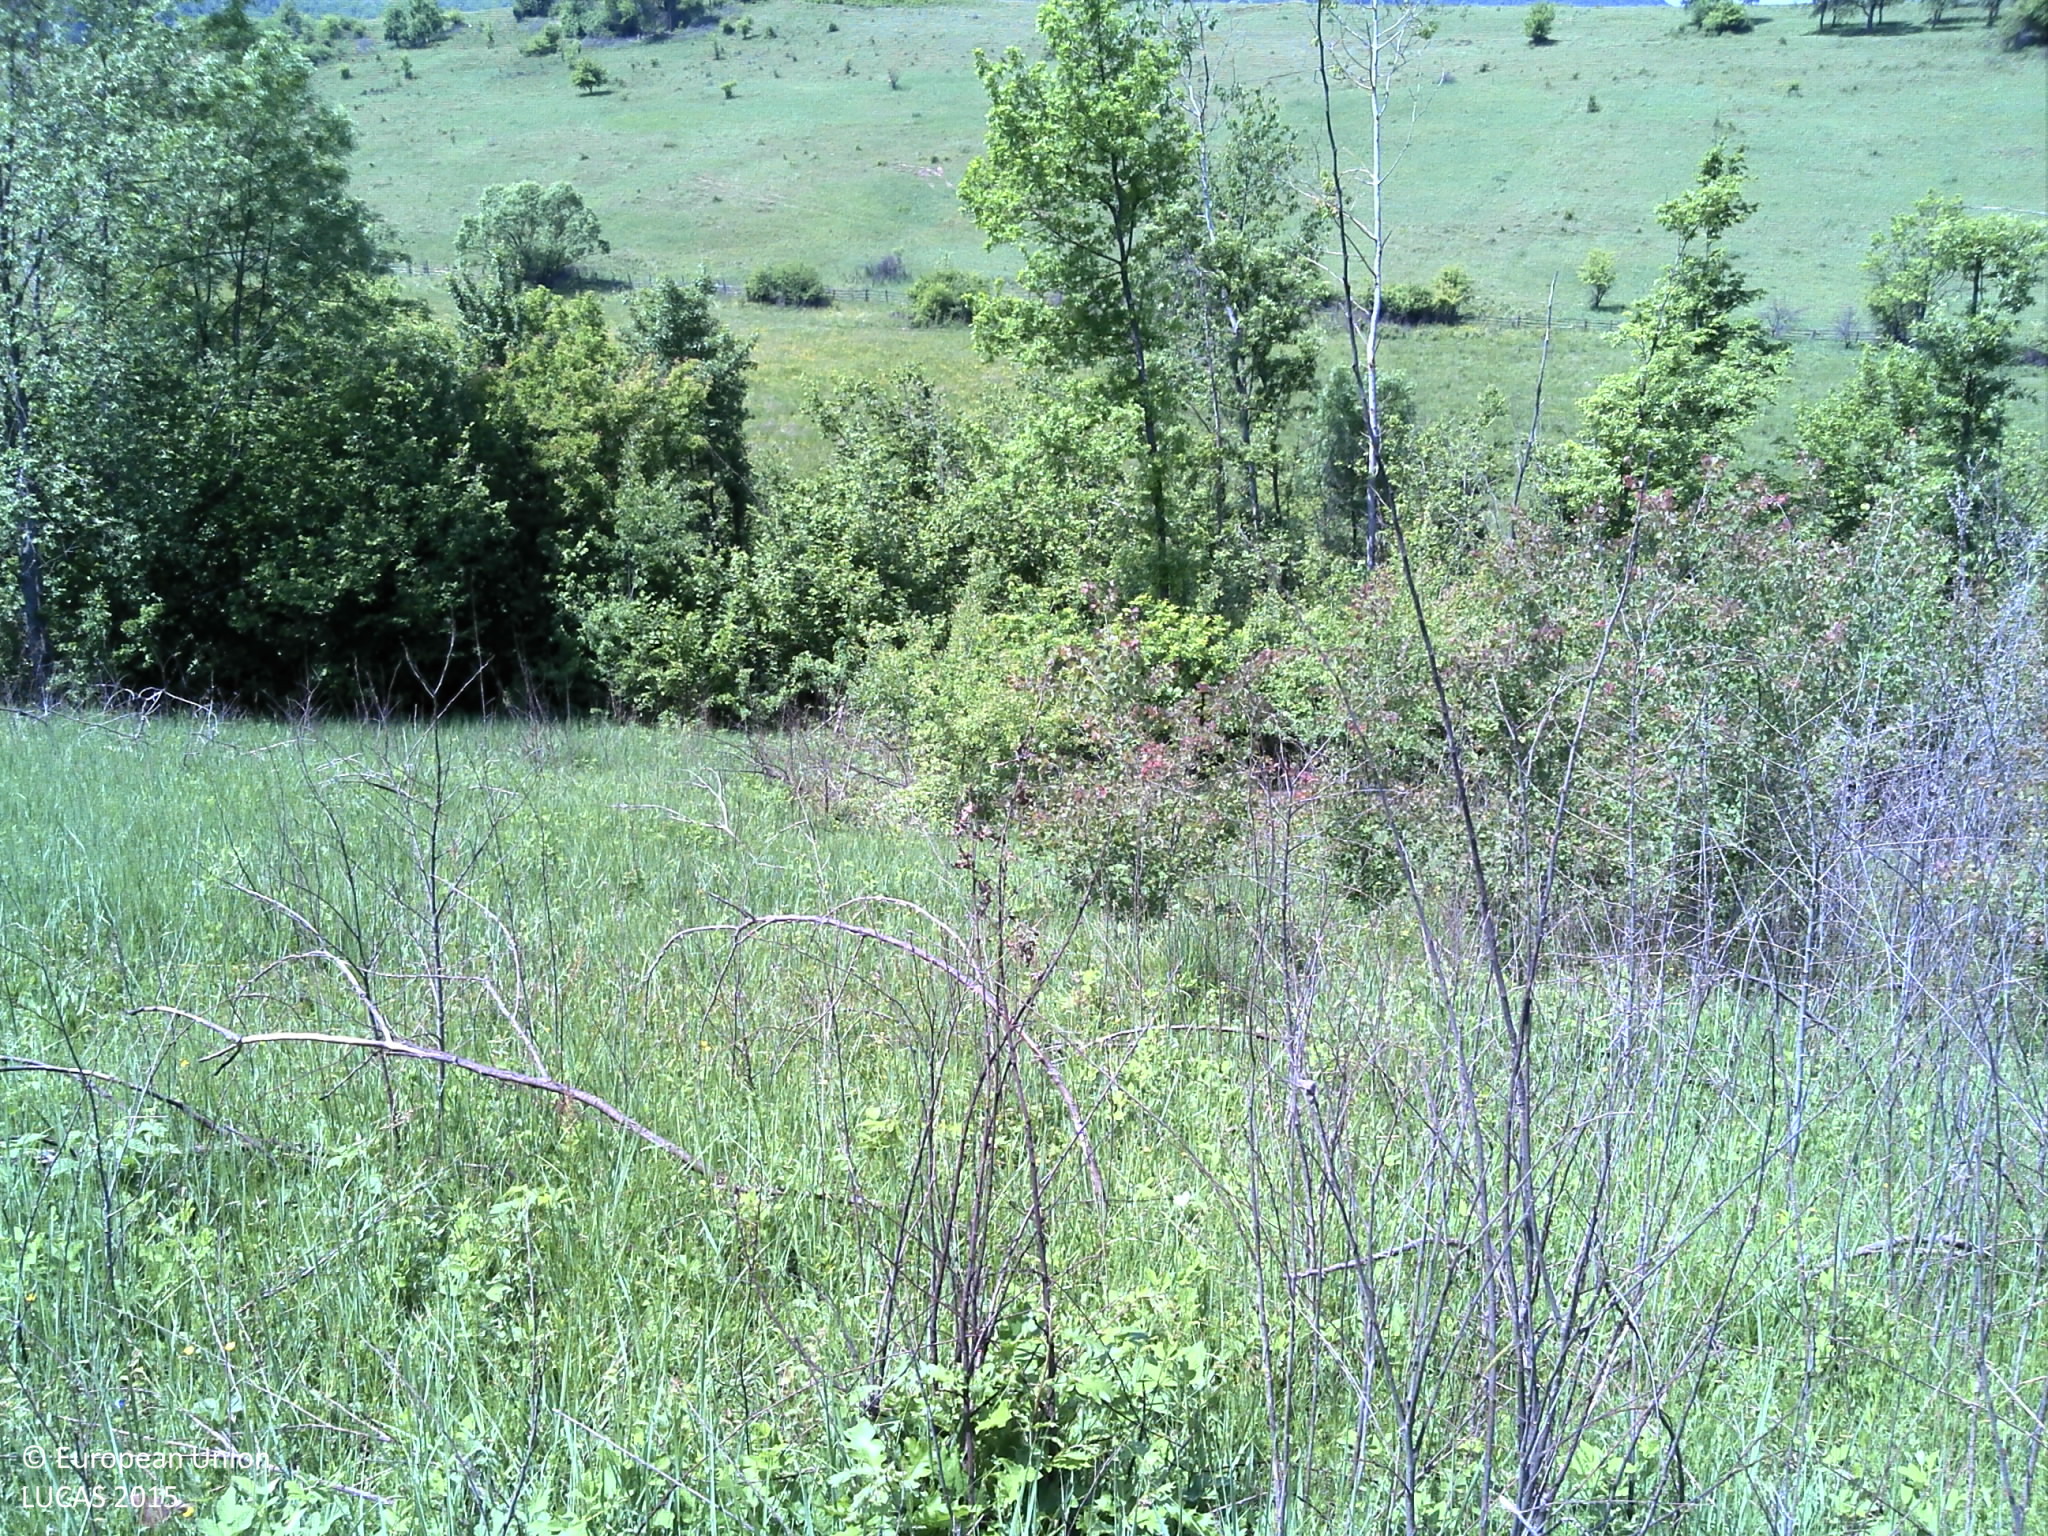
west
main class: Grassland
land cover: Spontaneously vegetated surfaces
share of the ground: > 75 %
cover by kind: herbaceous plants 95 %, shrubs 5 %
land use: Semi-natural and natural areas not in use
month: May
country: HR
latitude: 45.3909
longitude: 18.1147
